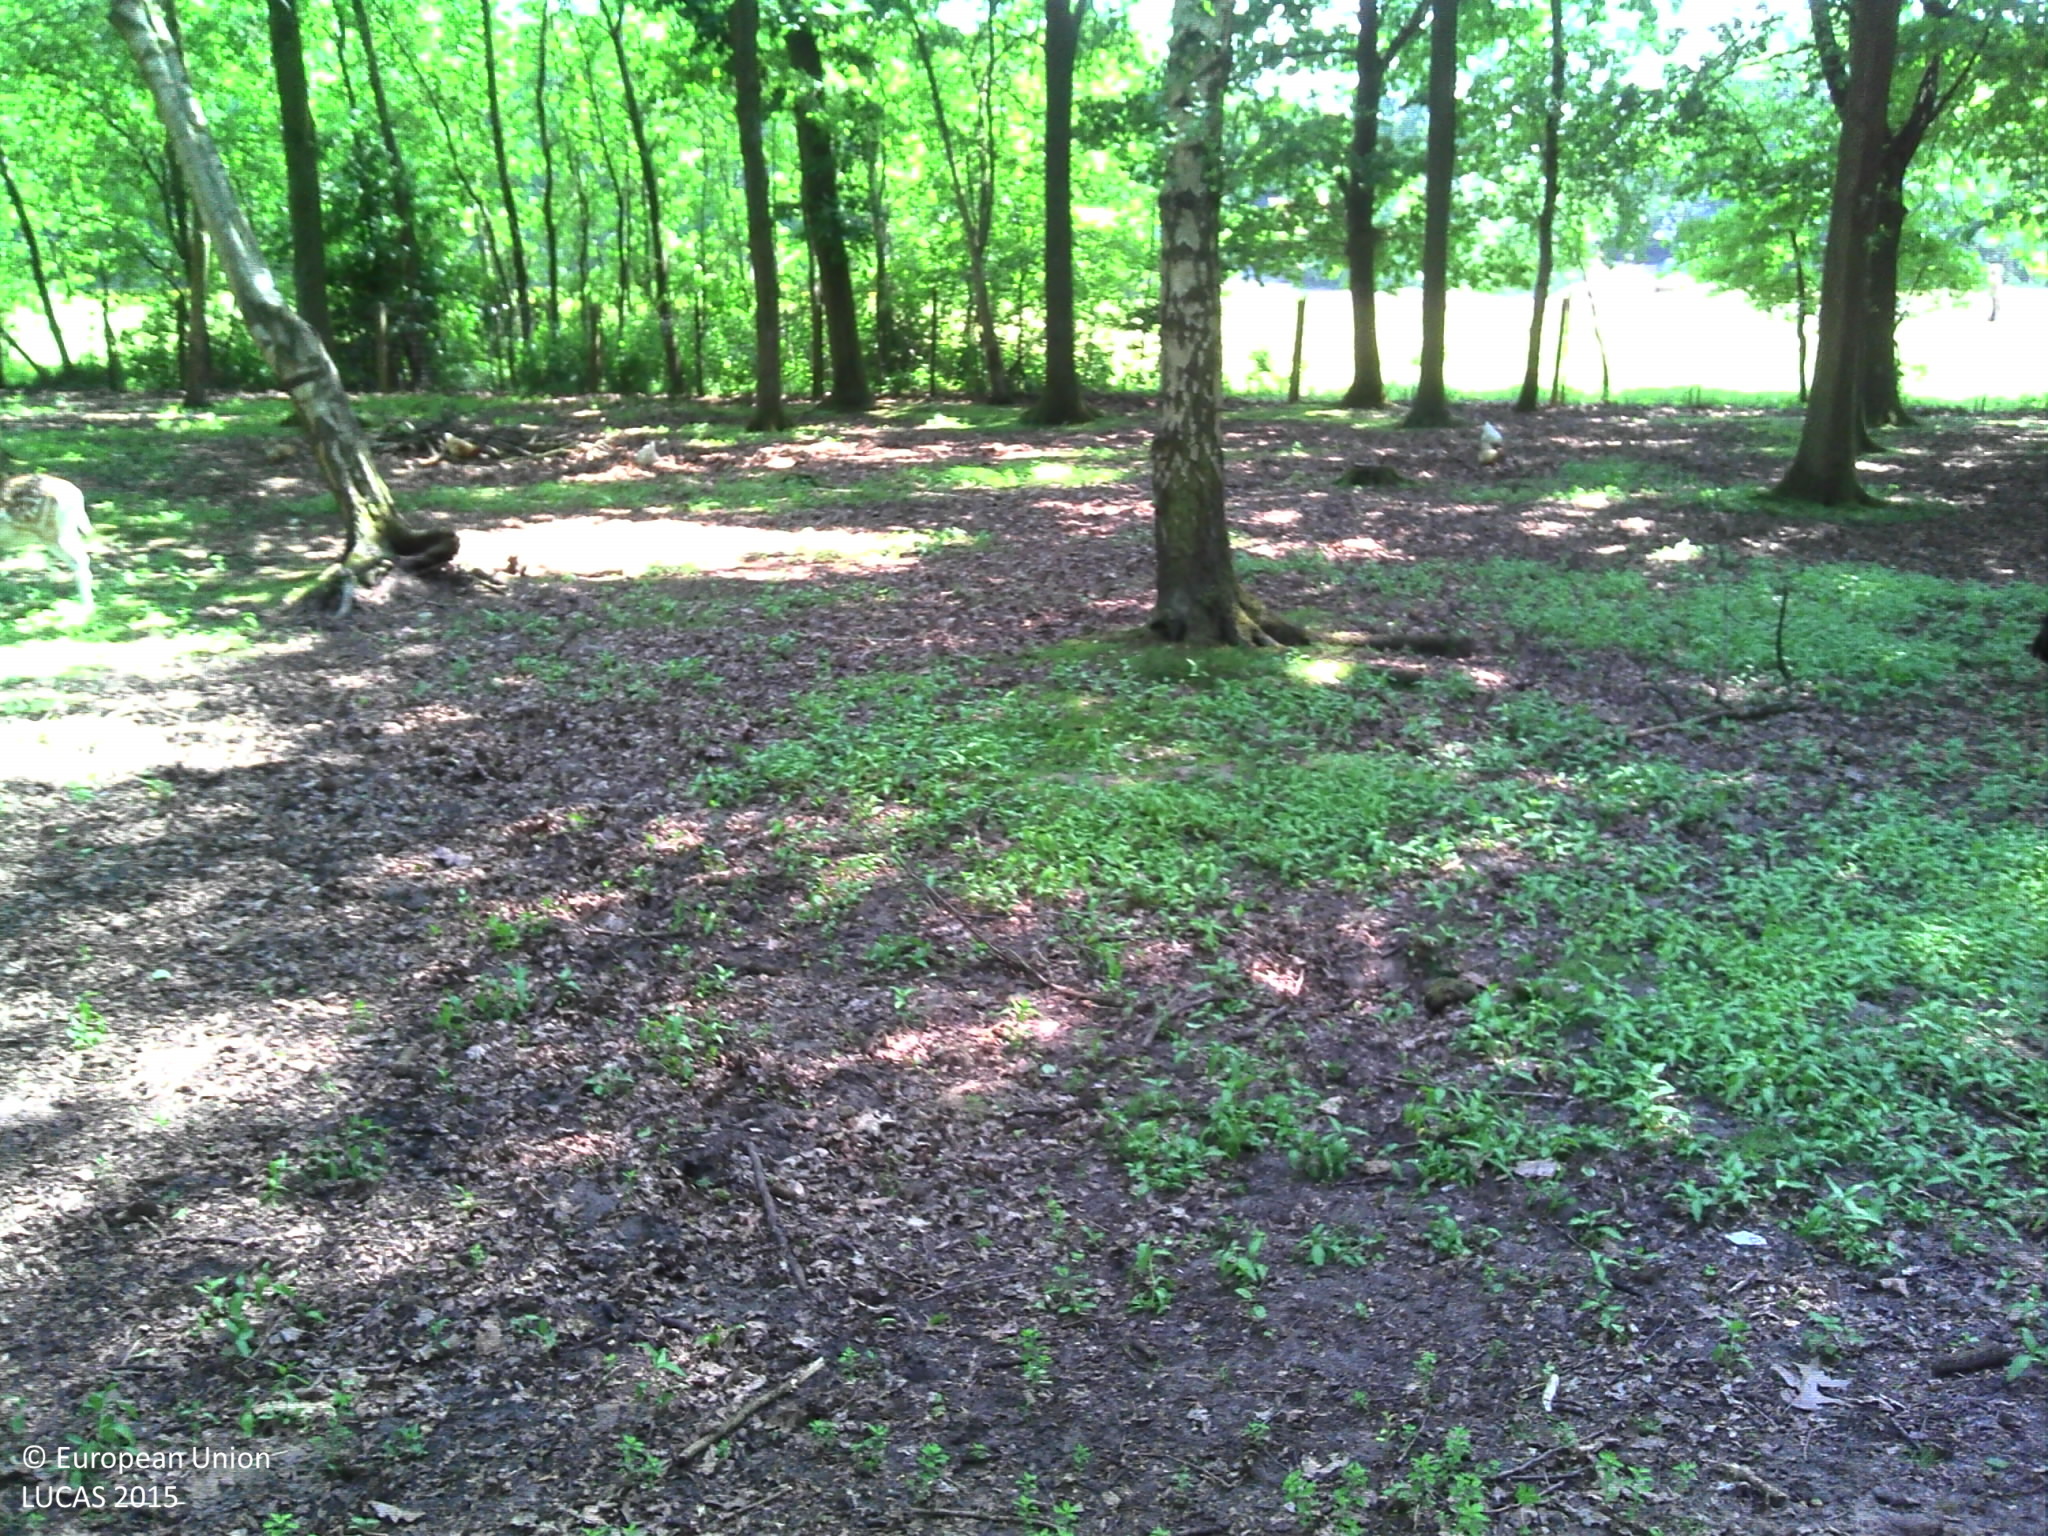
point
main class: Woodland
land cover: Broadleaved woodland
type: mesophytic deciduous forest
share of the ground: > 75 %
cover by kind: broadleaved forest trees 100 %
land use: Forestry
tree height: > 5 m
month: June
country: BE
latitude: 51.0175
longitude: 3.9927
